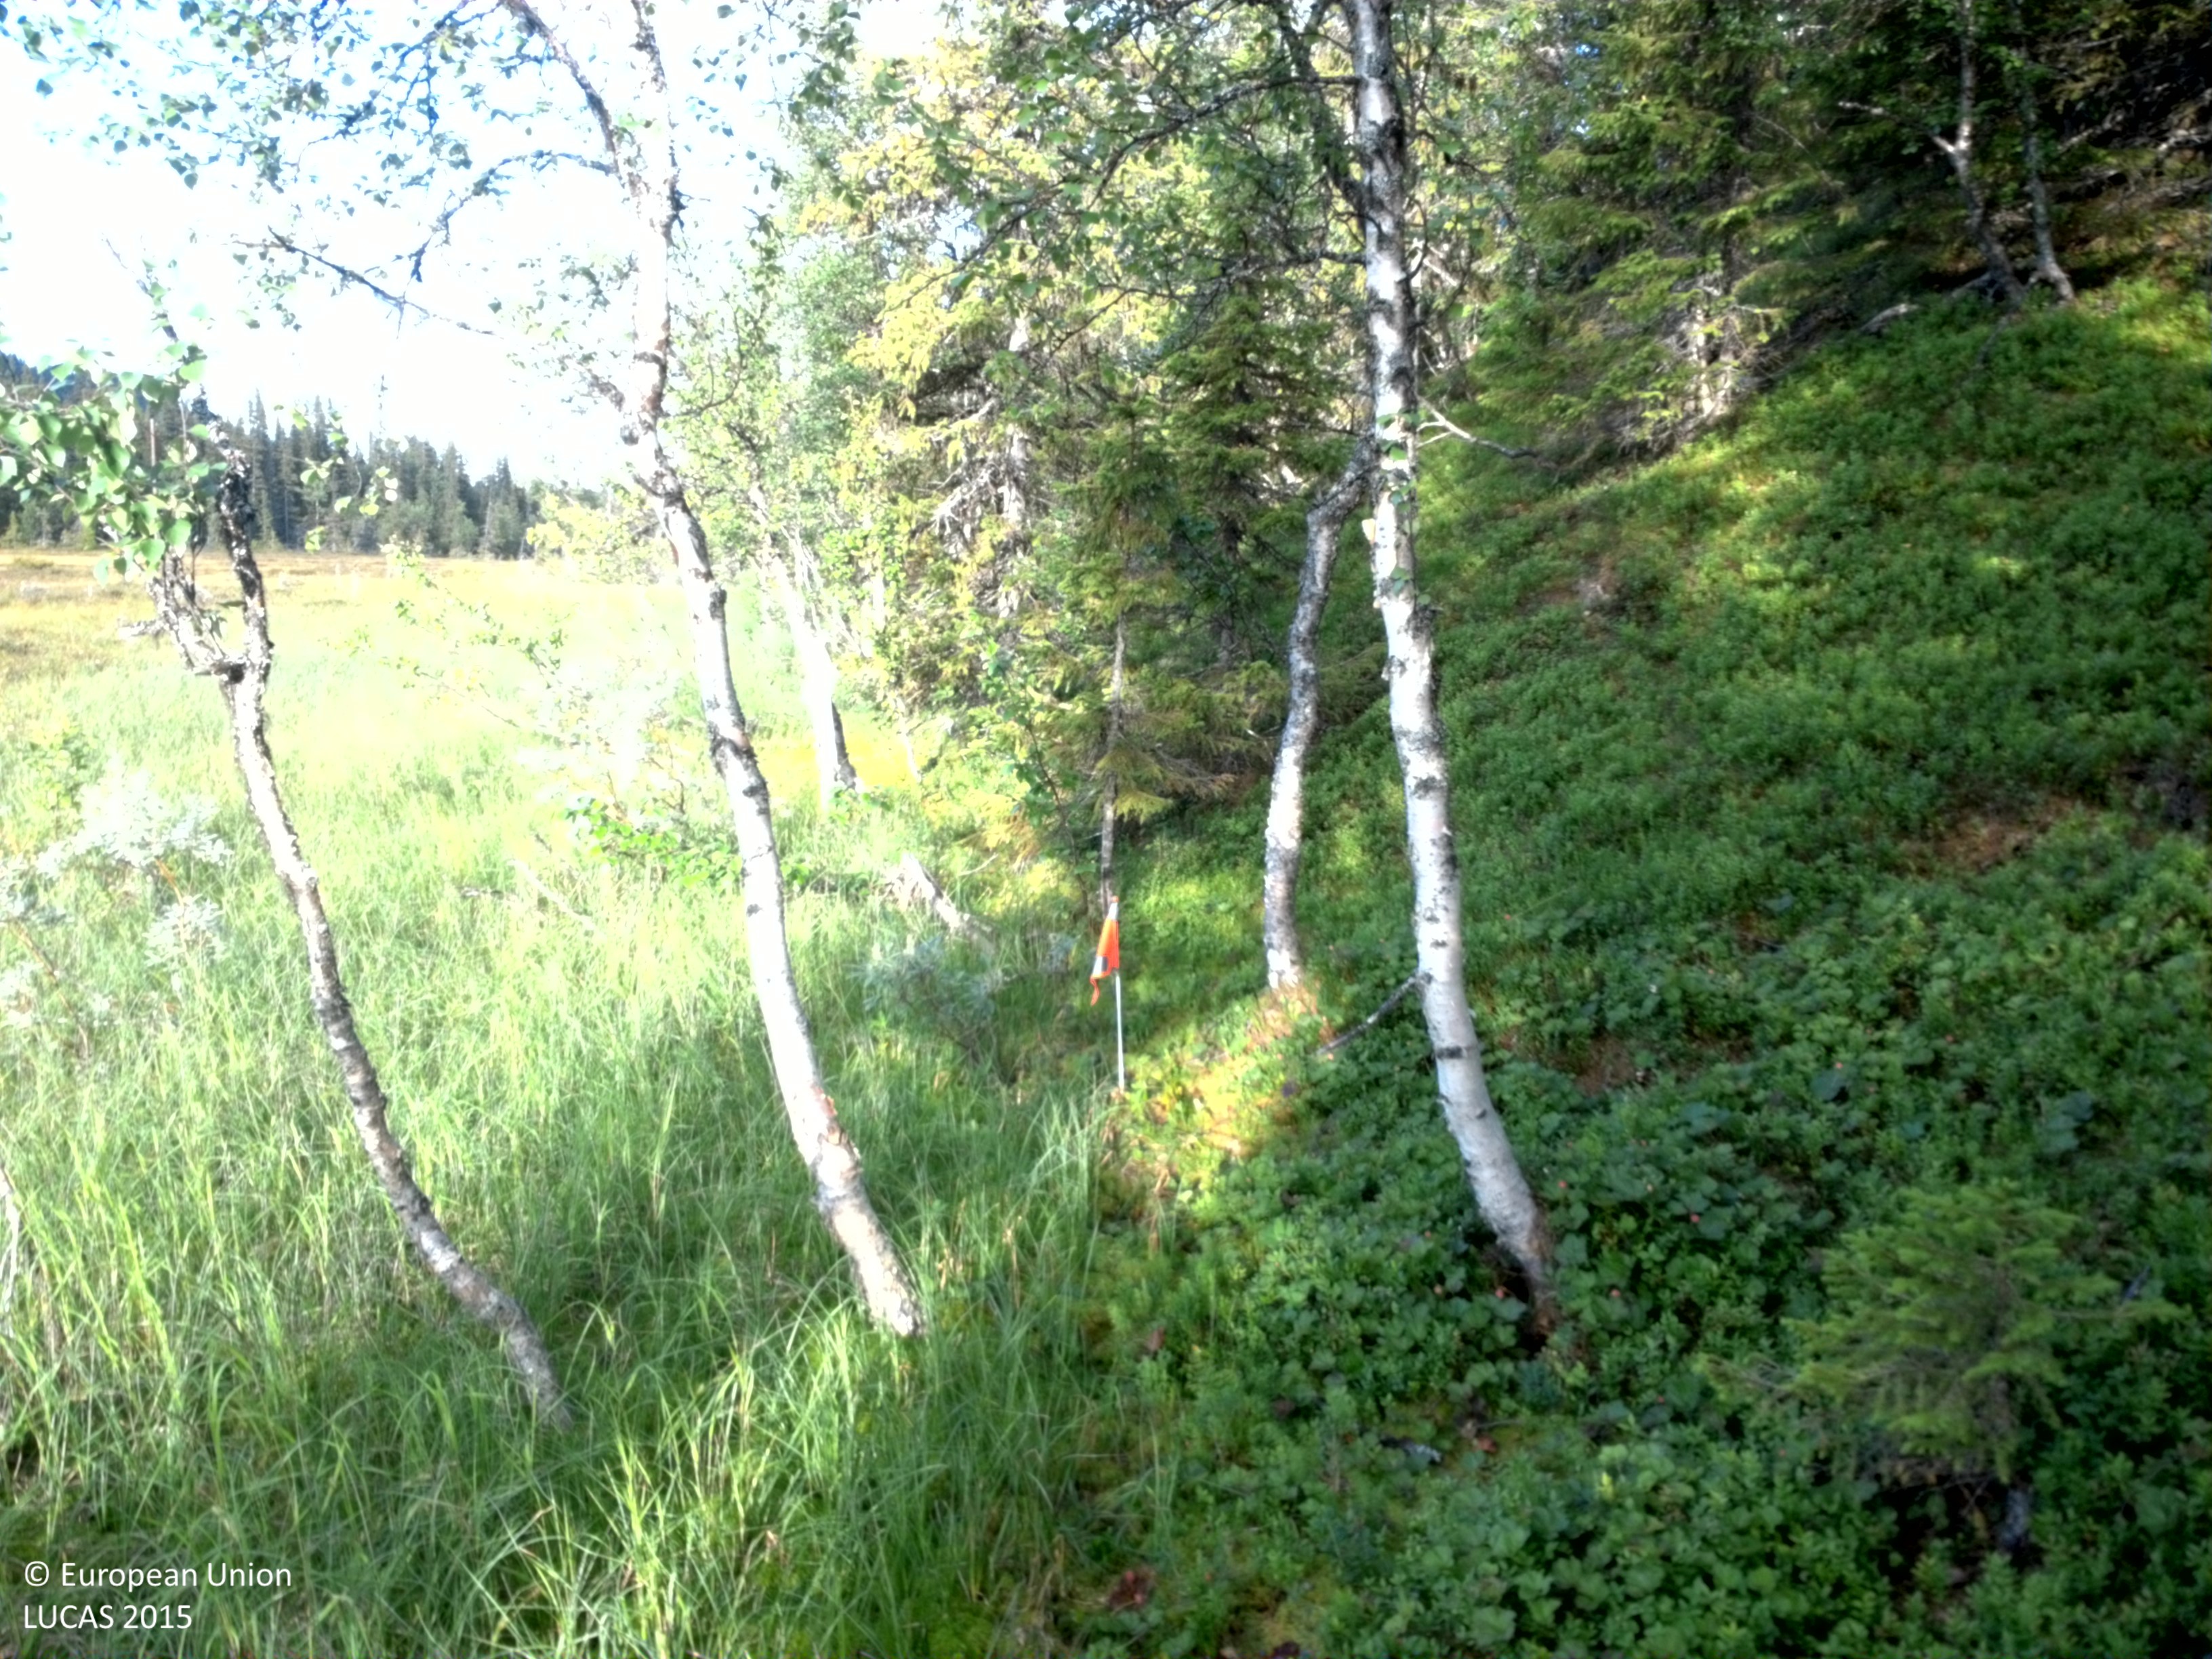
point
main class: Shrubland
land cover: Shrubland with sparse tree cover
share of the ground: 25 - 50 %
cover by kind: herbaceous plants 45 %, lichens and mosses 30 %, shrubs 20 %, broadleaved forest trees 5 %
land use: Semi-natural and natural areas not in use
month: August
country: SE
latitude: 64.8995
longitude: 15.5244
